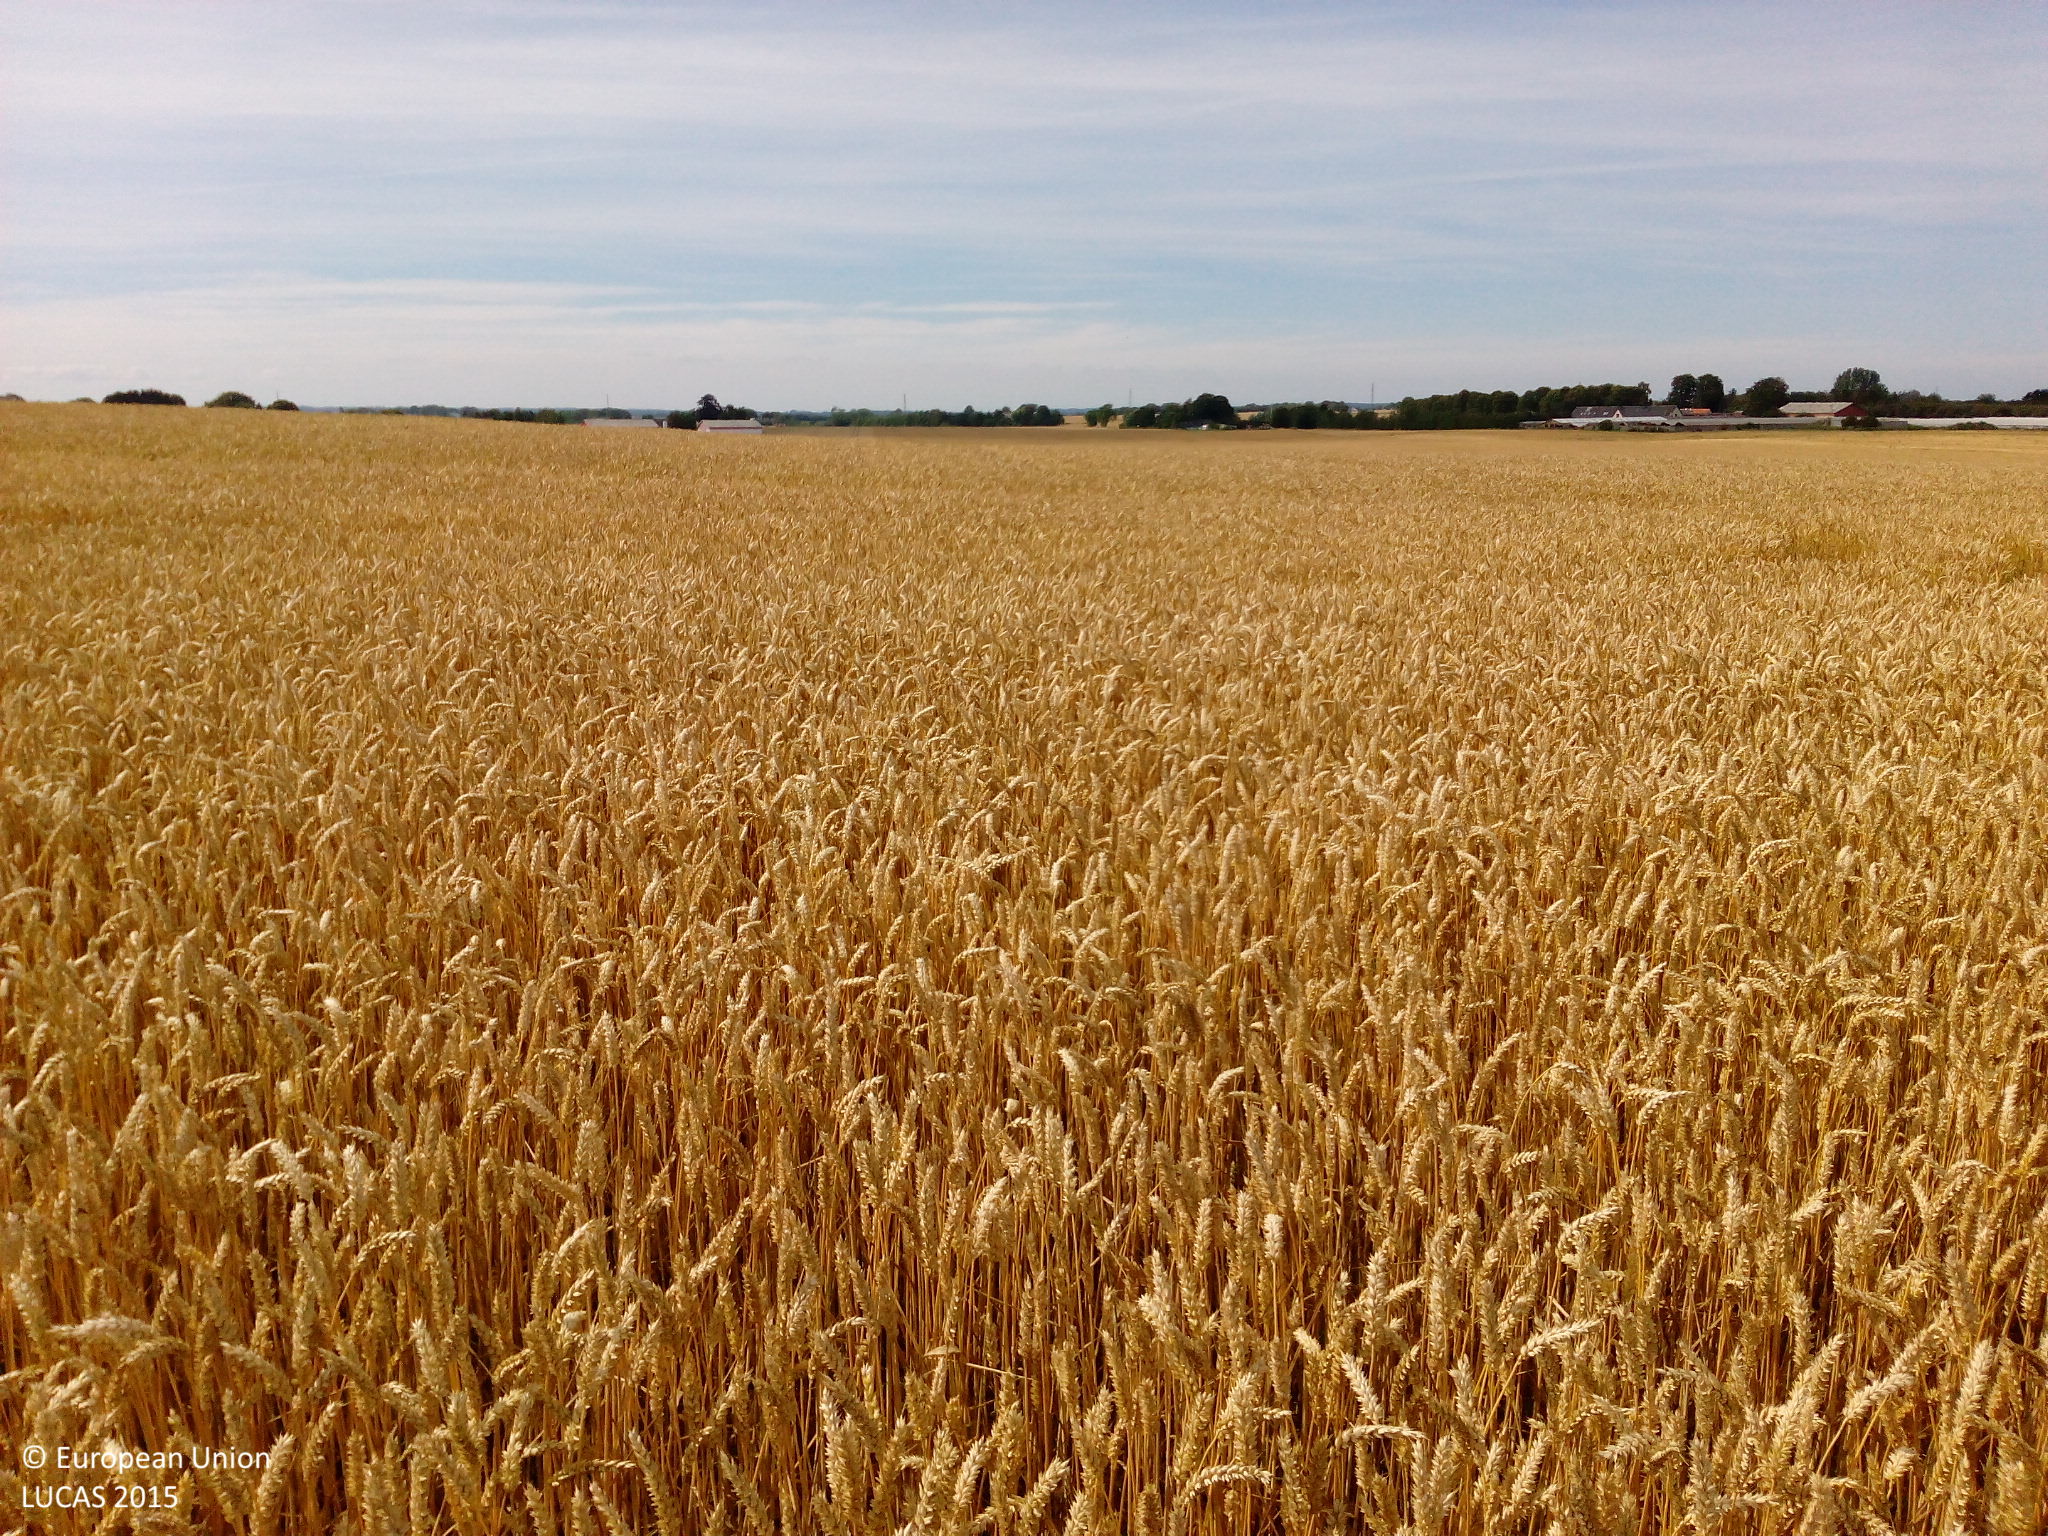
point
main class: Cropland
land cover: Common wheat
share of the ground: > 75 %
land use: Agriculture (excluding fallow land and kitchen gardens)
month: August
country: DK
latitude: 55.5596
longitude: 12.0753
